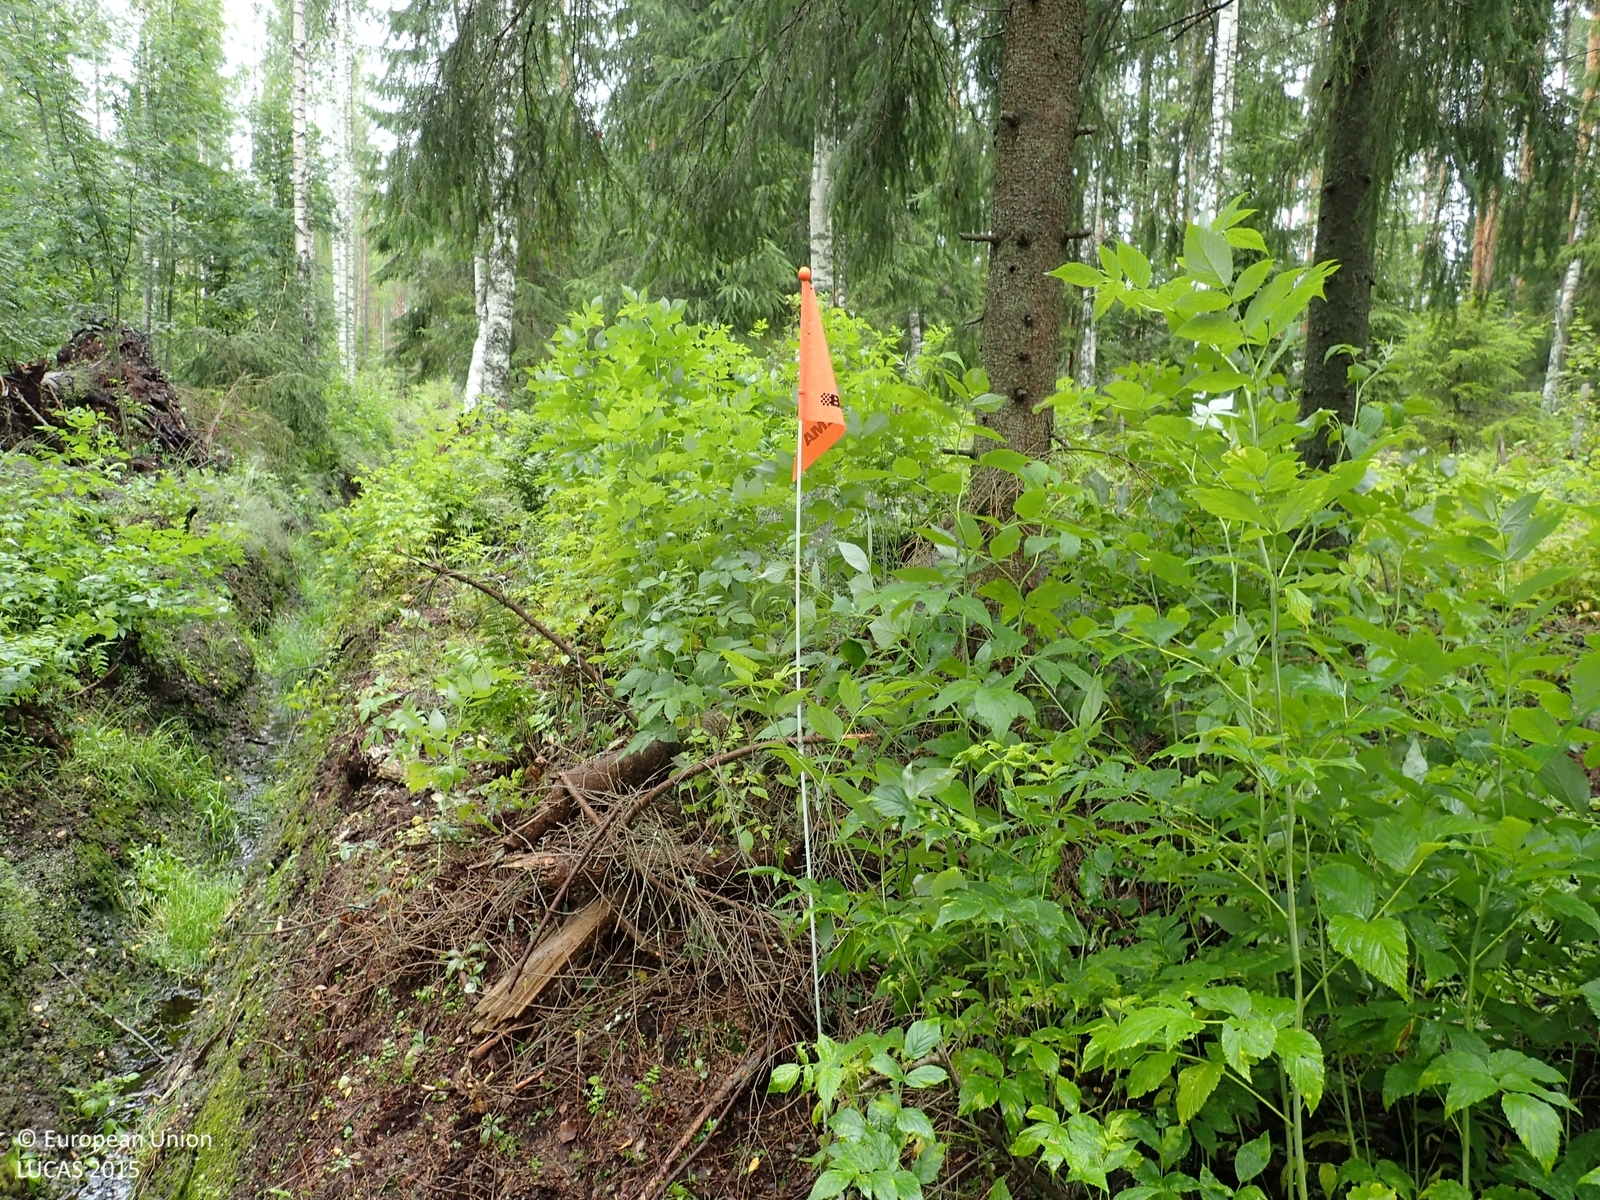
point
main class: Woodland
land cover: Other mixed woodland
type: boreal forest
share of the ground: 50 - 75 %
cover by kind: coniferous forest trees 45 %, herbaceous plants 40 %, broadleaved forest trees 15 %
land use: Forestry
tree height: > 5 m
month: July
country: FI
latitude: 62.9067
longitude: 22.7900
